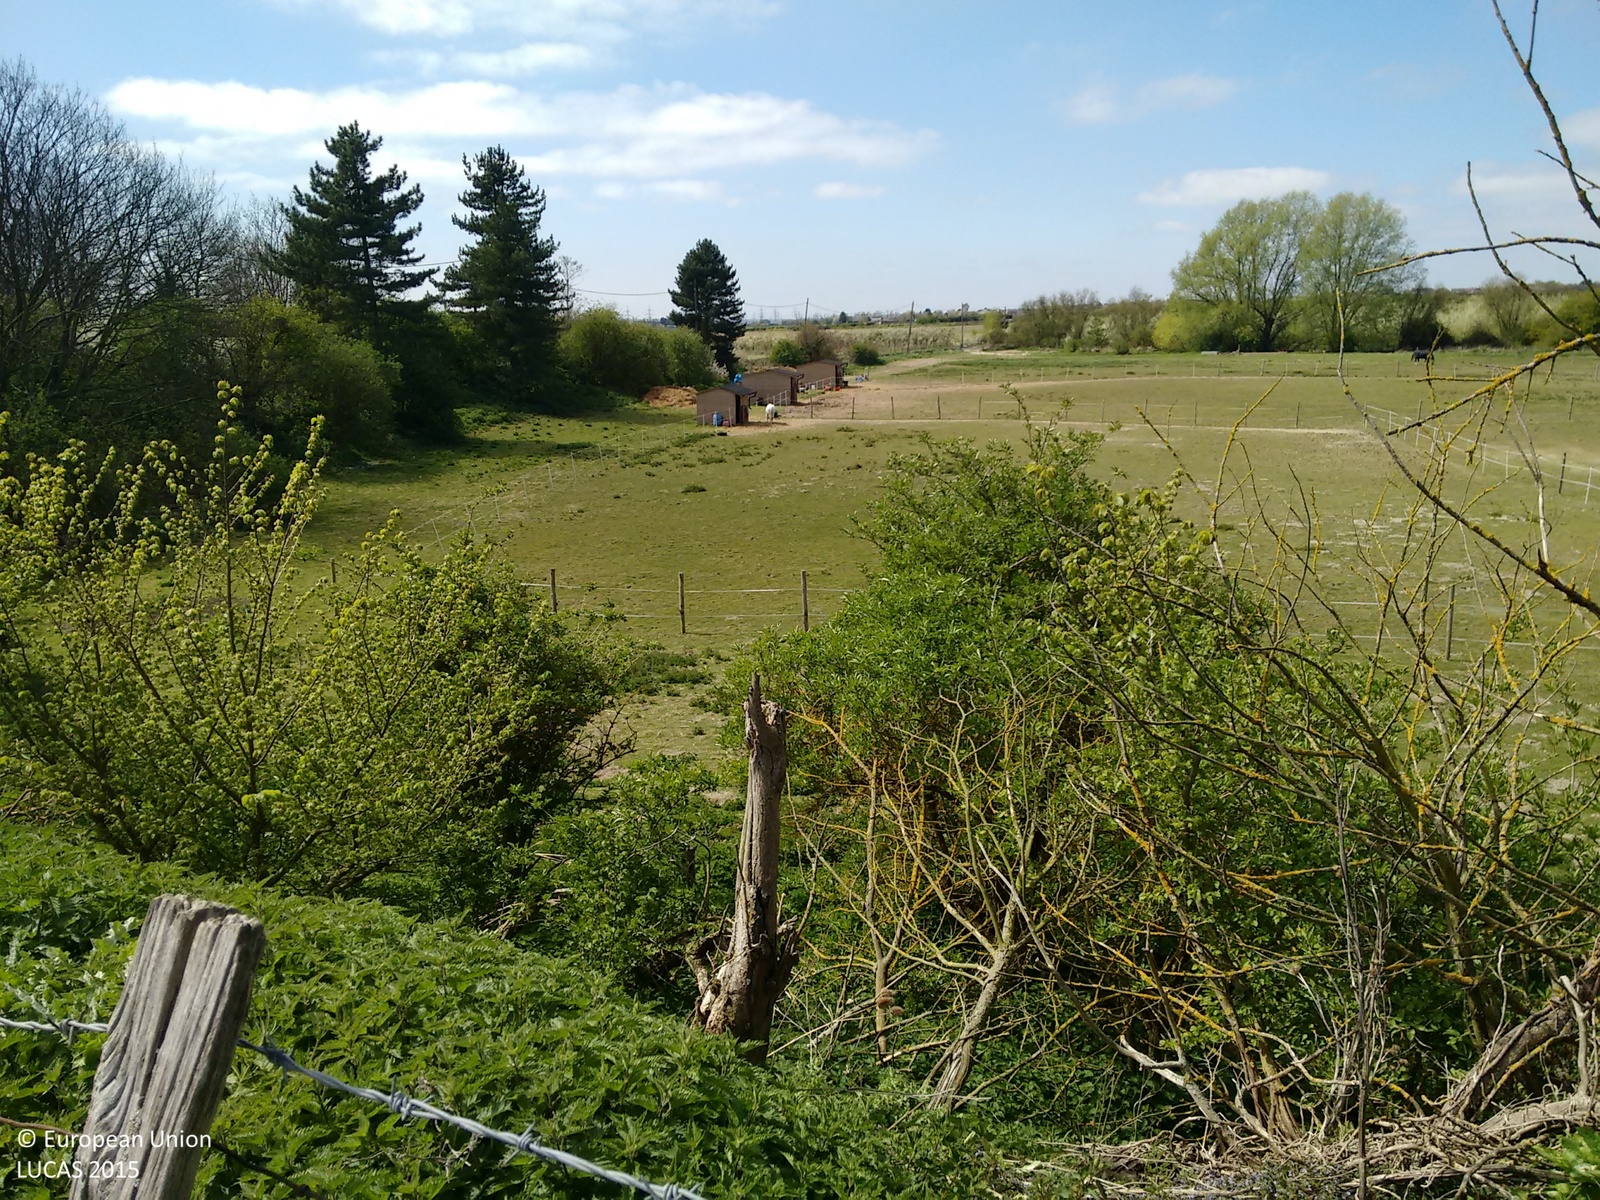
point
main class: Grassland
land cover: Grassland without tree/shrub cover
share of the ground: > 75 %
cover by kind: herbaceous plants 80 %, unconsolidated bare surface 20 %
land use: Agriculture (excluding fallow land and kitchen gardens)
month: April
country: GB
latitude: 51.4540
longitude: 0.5174
